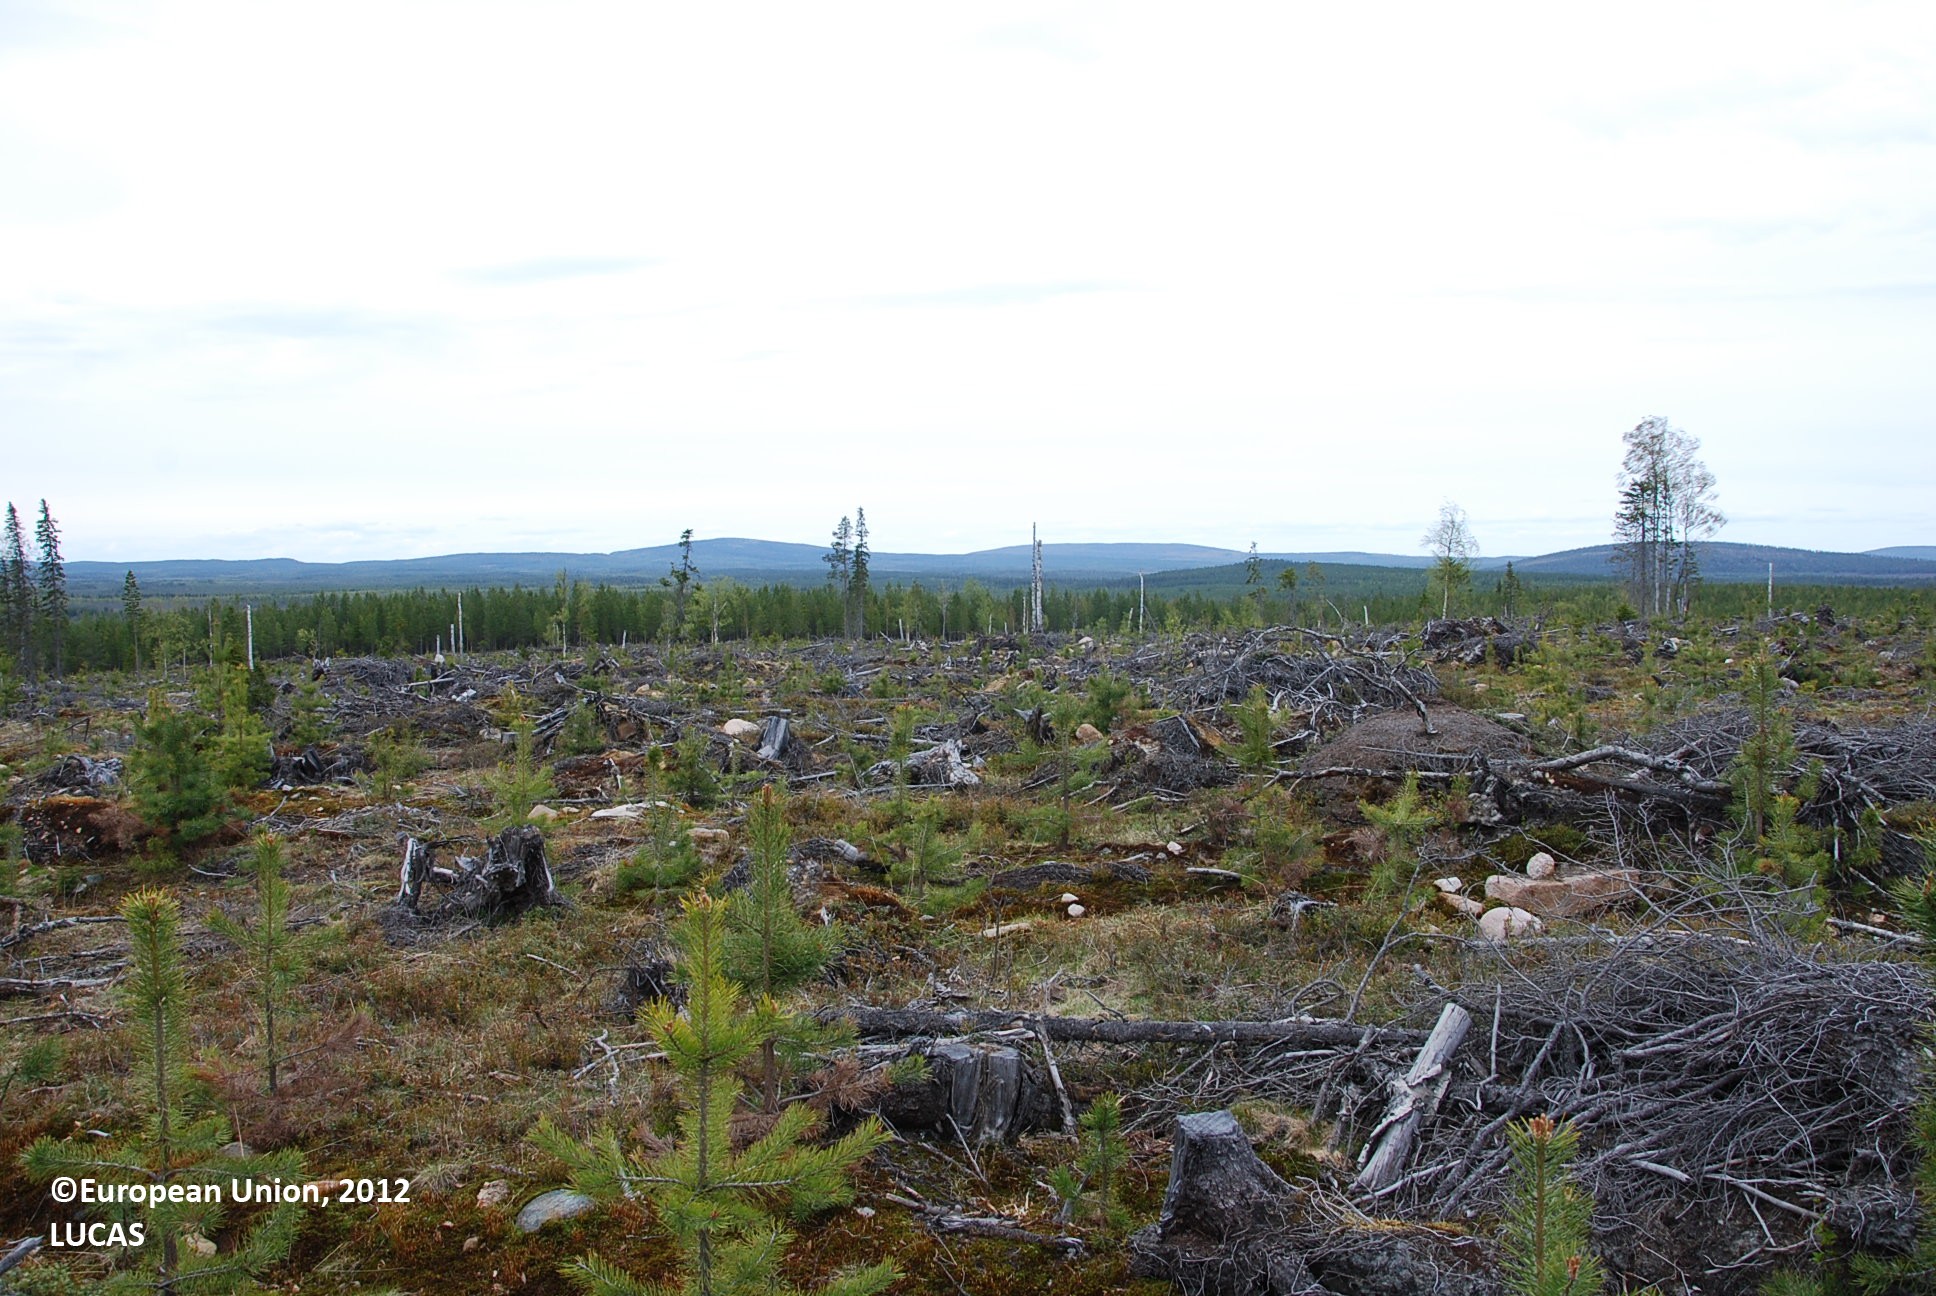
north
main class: Woodland
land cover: Pine dominated coniferous woodland
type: boreal forest
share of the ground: 10 - 25 %
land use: Forestry
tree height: < 5 m
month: June
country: FI
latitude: 66.8094
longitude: 28.1759
